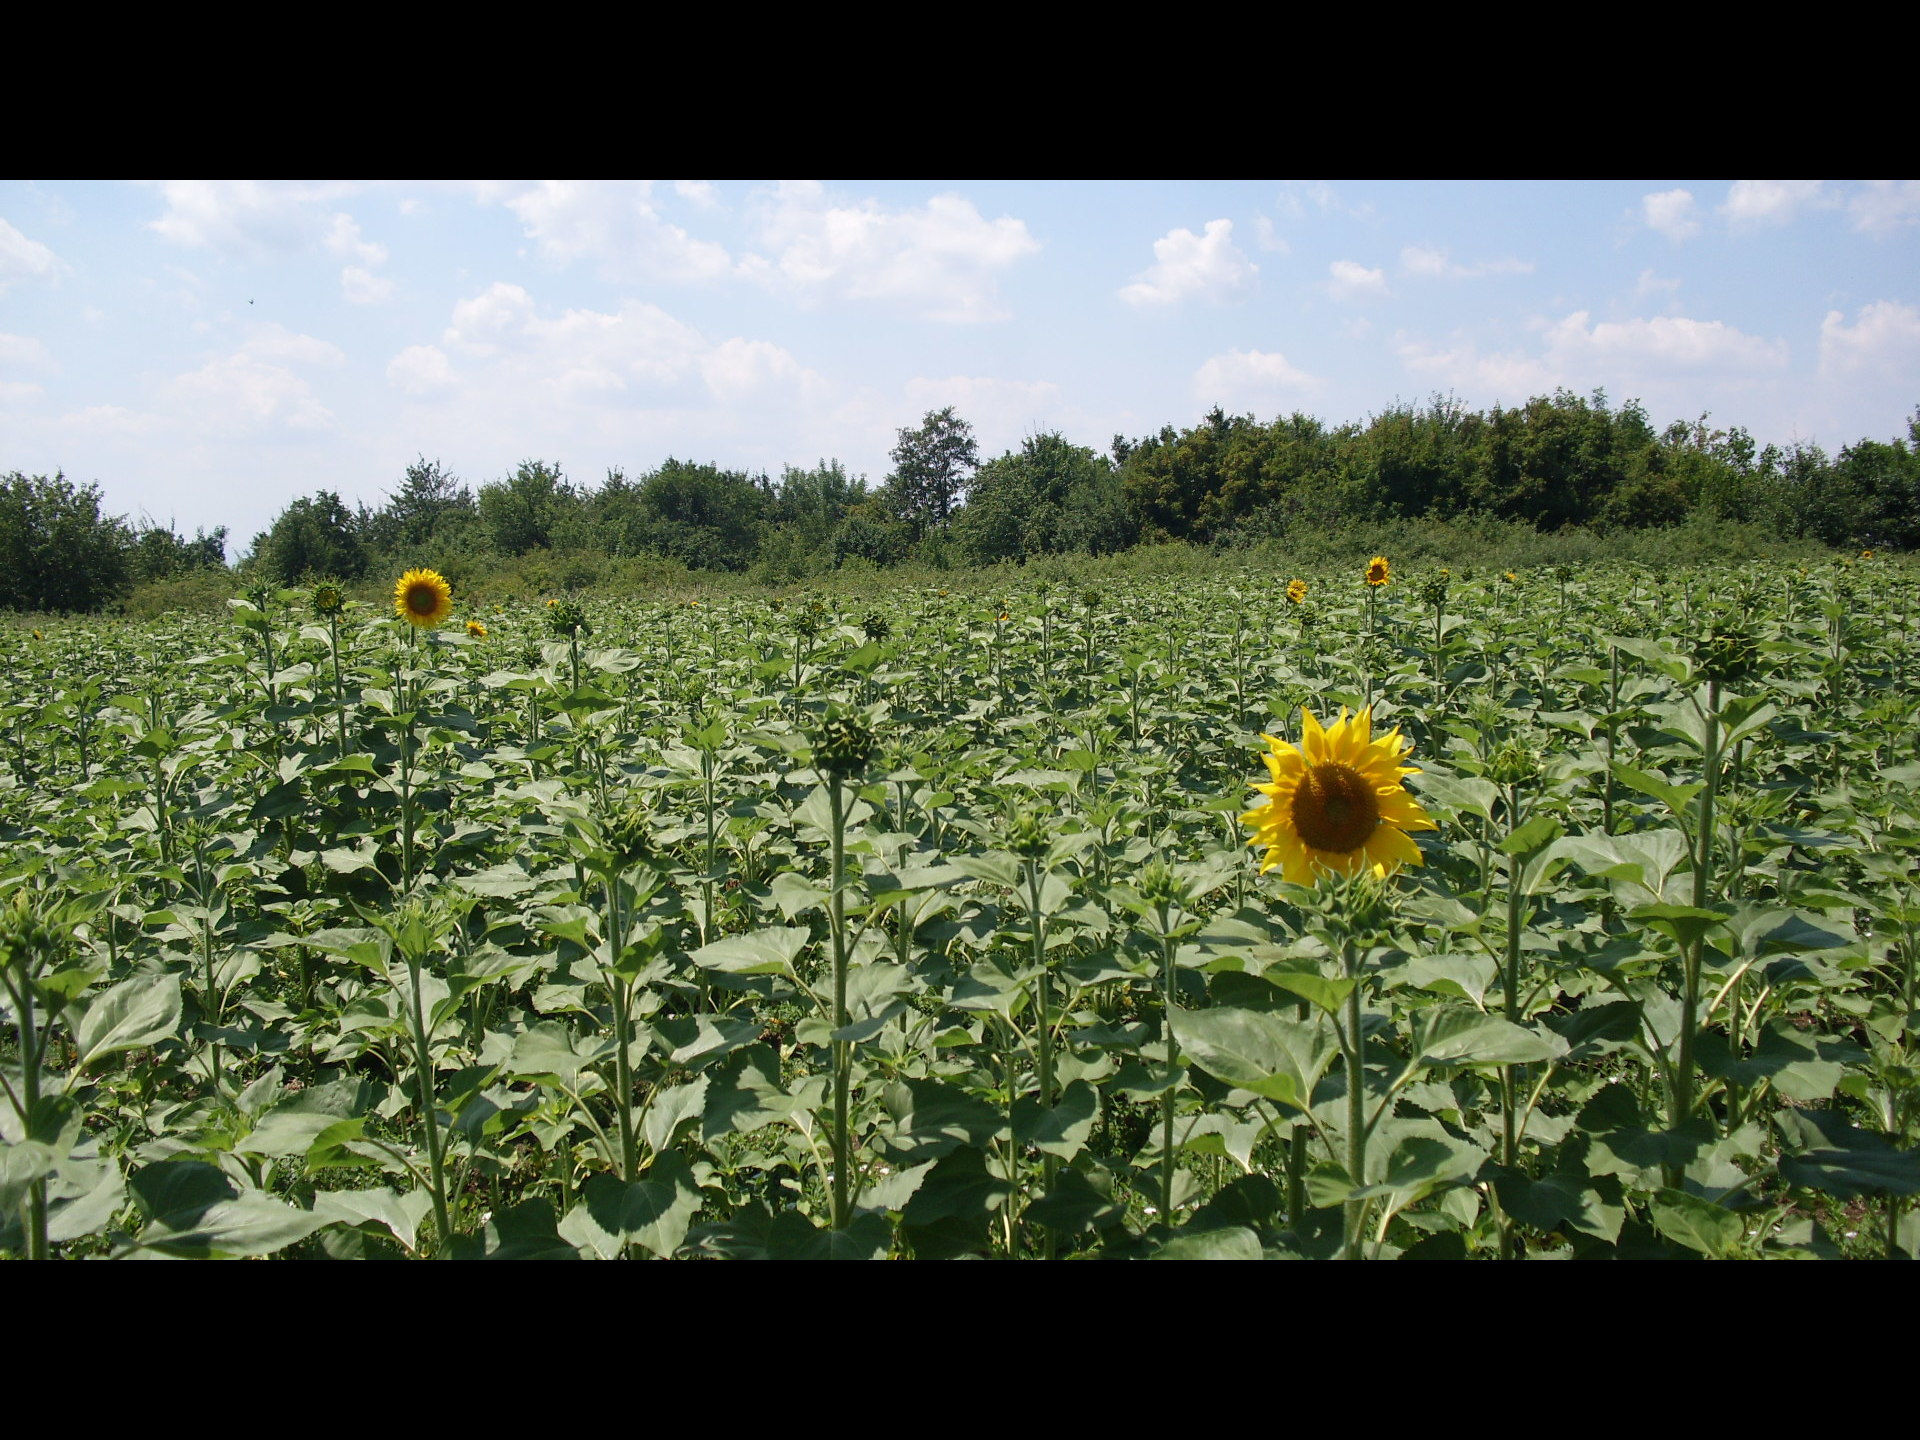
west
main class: Cropland
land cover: Sunflower
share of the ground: > 75 %
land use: Agriculture (excluding fallow land and kitchen gardens)
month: July
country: BG
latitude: 43.7675
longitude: 22.8448
